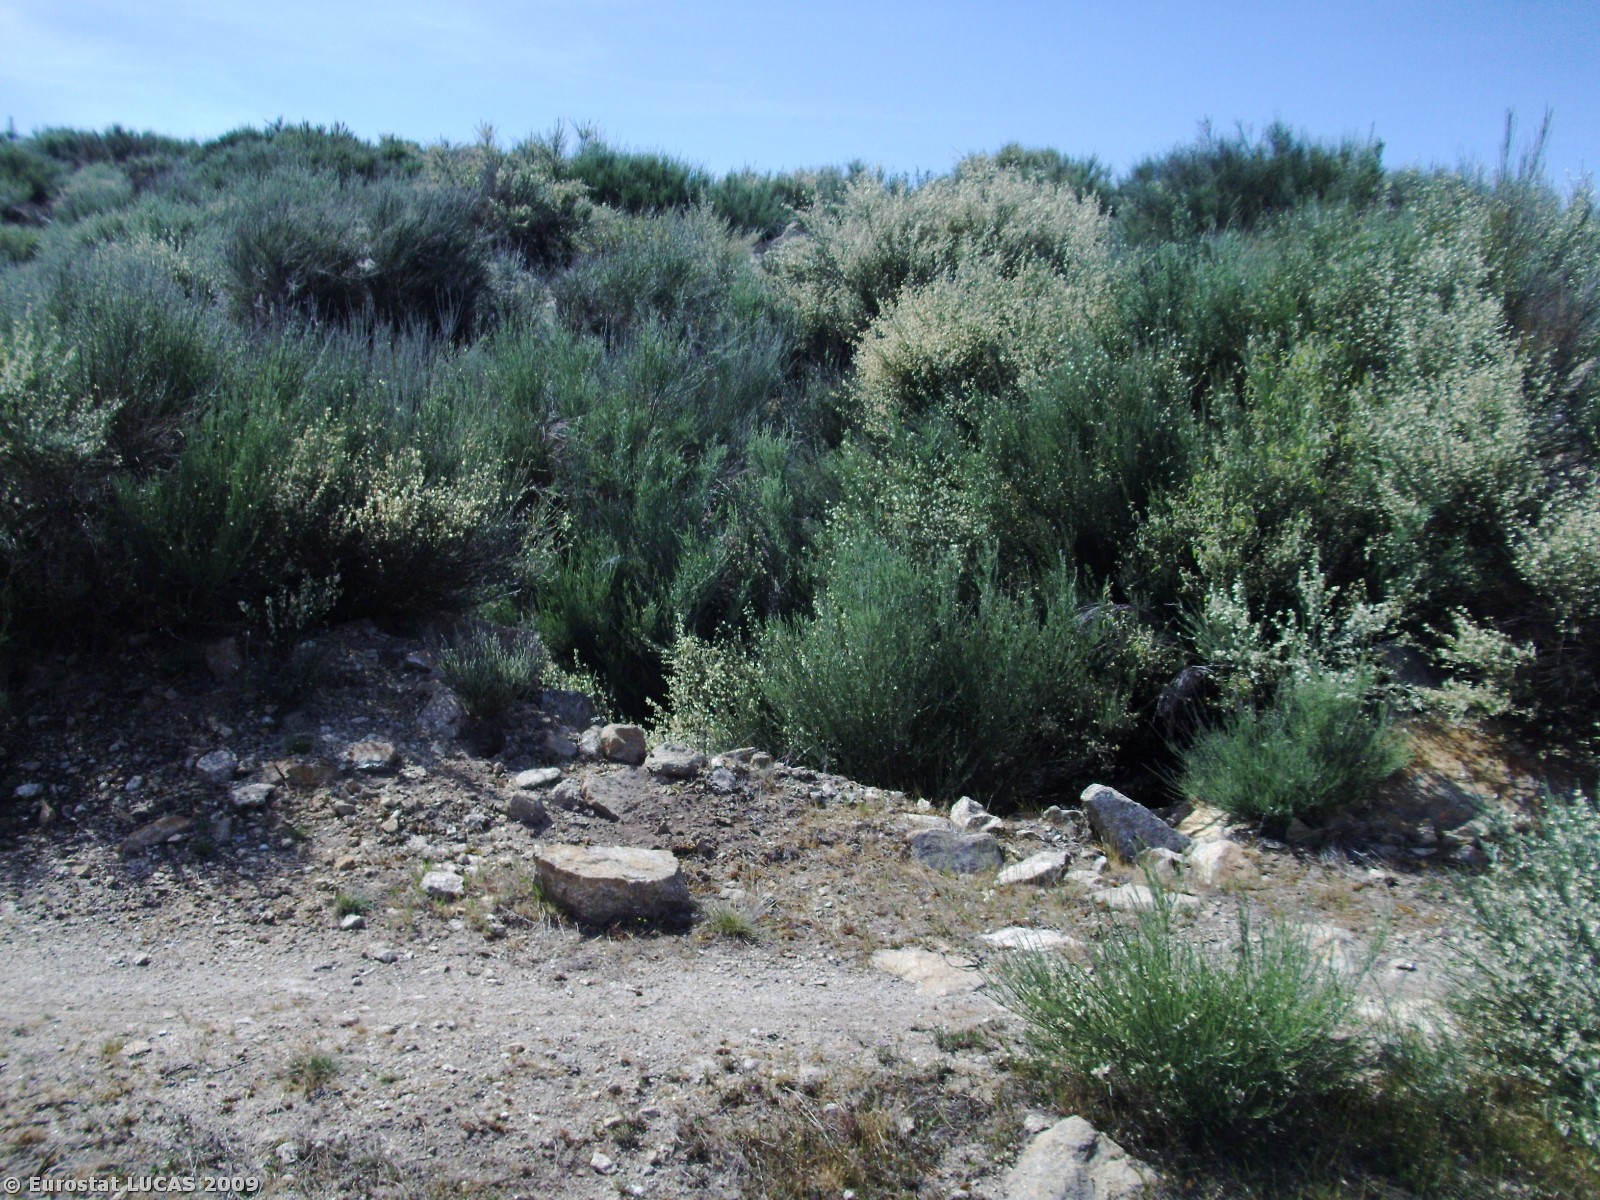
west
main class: Woodland
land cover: Coniferous woodland
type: coniferous forest of the mediterranean region
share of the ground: > 75 %
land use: Forestry
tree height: > 5 m
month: May
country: PT
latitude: 40.9405
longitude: -7.3492
